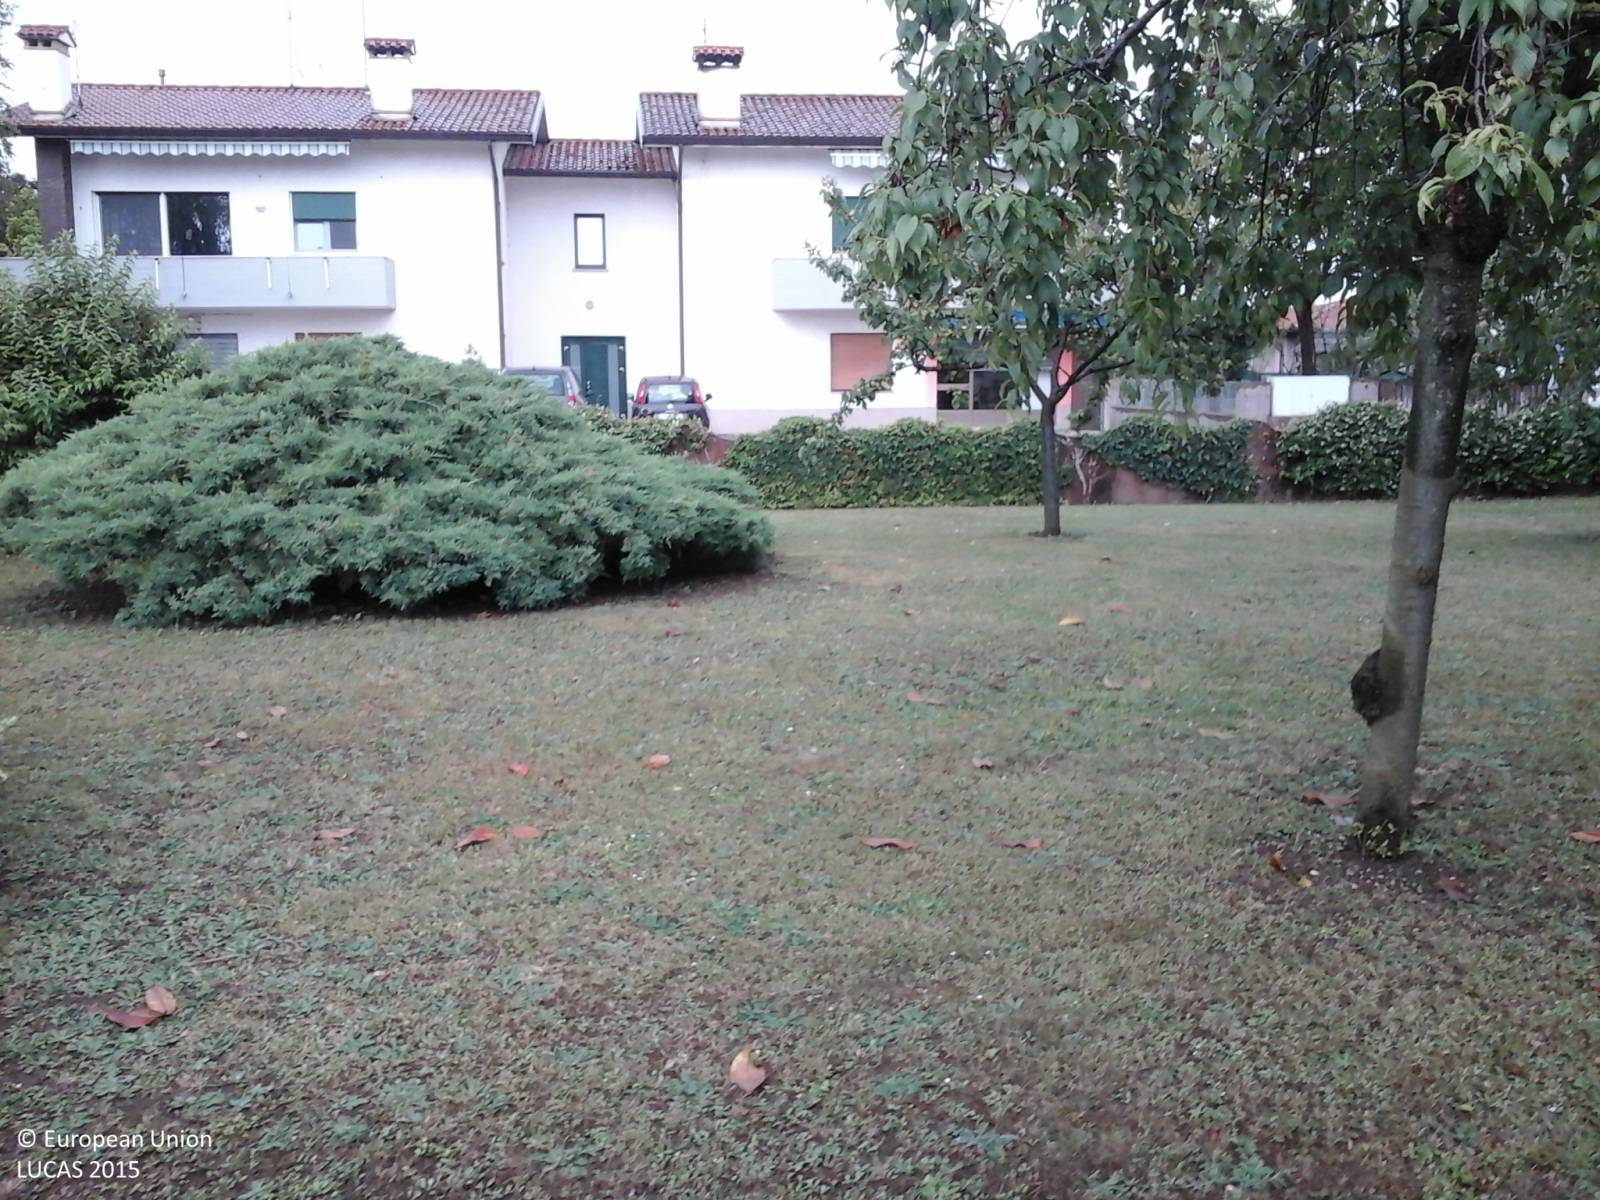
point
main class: Grassland
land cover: Grassland with sparse tree/shrub cover
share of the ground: > 75 %
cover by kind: herbaceous plants 80 %, consolidated bare surface 10 %, coniferous forest trees 5 %, shrubs 5 %
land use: Residential
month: June
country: IT
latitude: 46.0629
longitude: 13.3962
